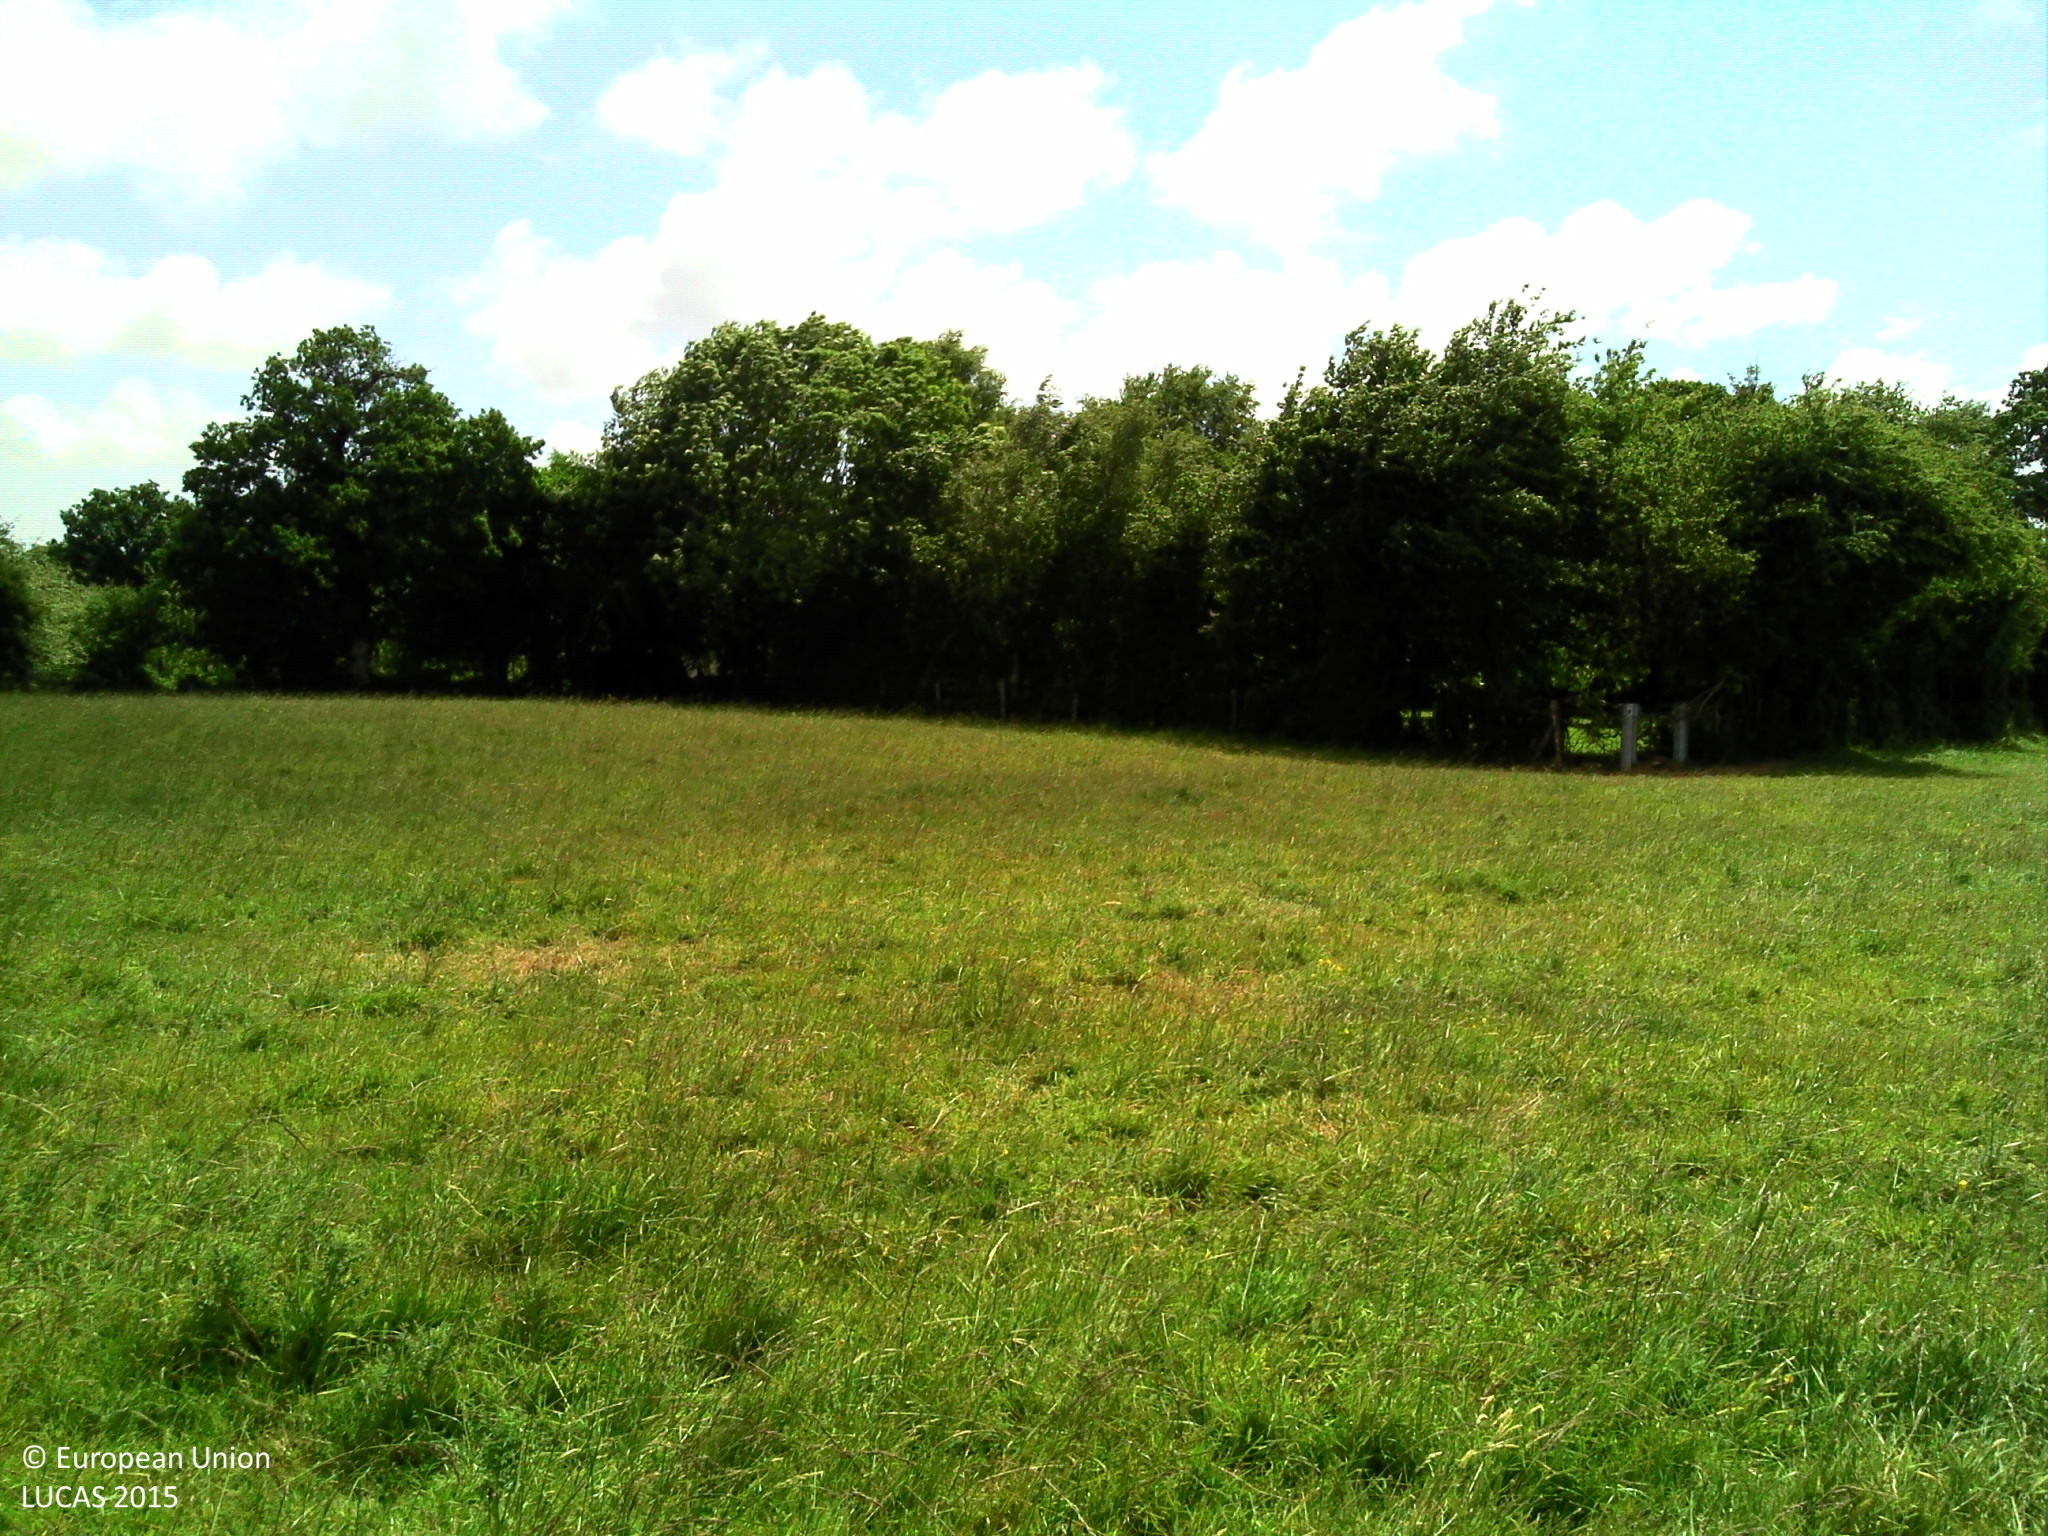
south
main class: Grassland
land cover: Grassland without tree/shrub cover
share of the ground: > 75 %
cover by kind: herbaceous plants 100 %
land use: Agriculture (excluding fallow land and kitchen gardens)
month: June
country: FR
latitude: 49.5710
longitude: -1.4291
